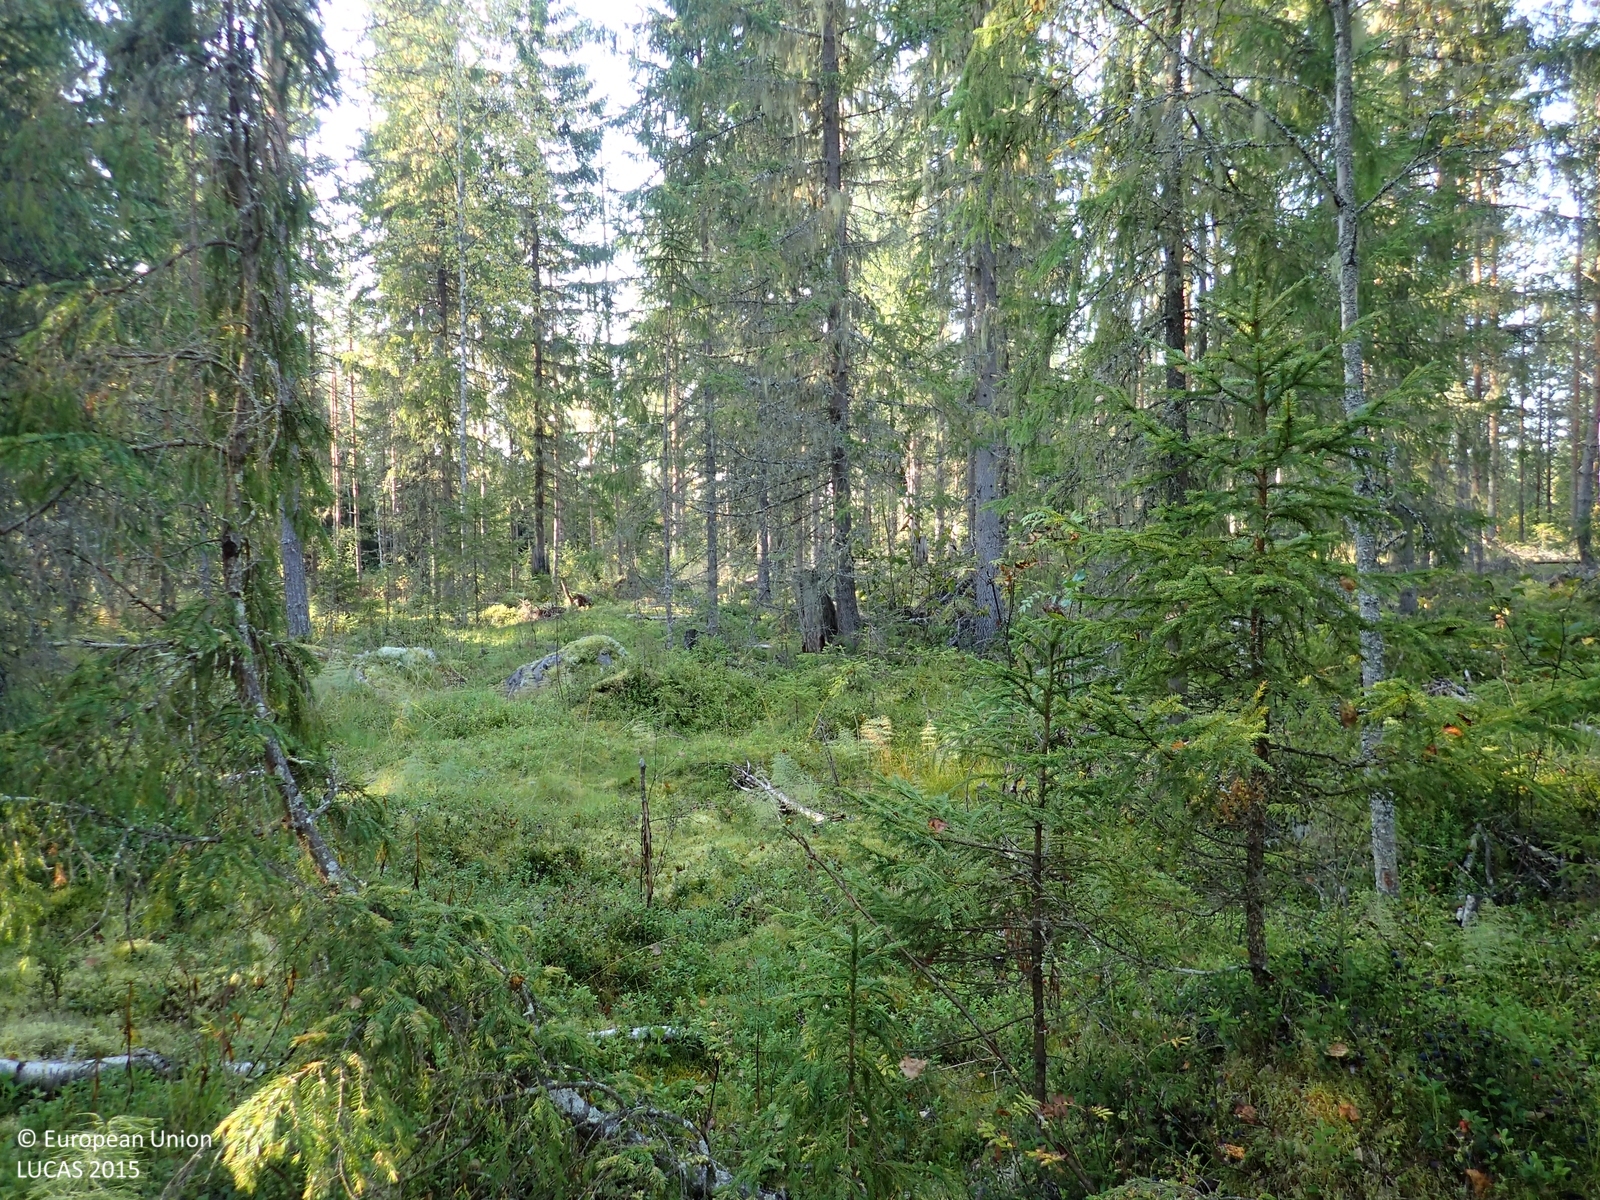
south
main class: Woodland
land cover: Spruce dominated coniferous woodland
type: boreal forest
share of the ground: > 75 %
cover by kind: coniferous forest trees 70 %, shrubs 15 %, broadleaved forest trees 5 %, herbaceous plants 5 %, lichens and mosses 5 %
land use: Forestry
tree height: > 5 m
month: September
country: FI
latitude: 63.0887
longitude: 25.3715
